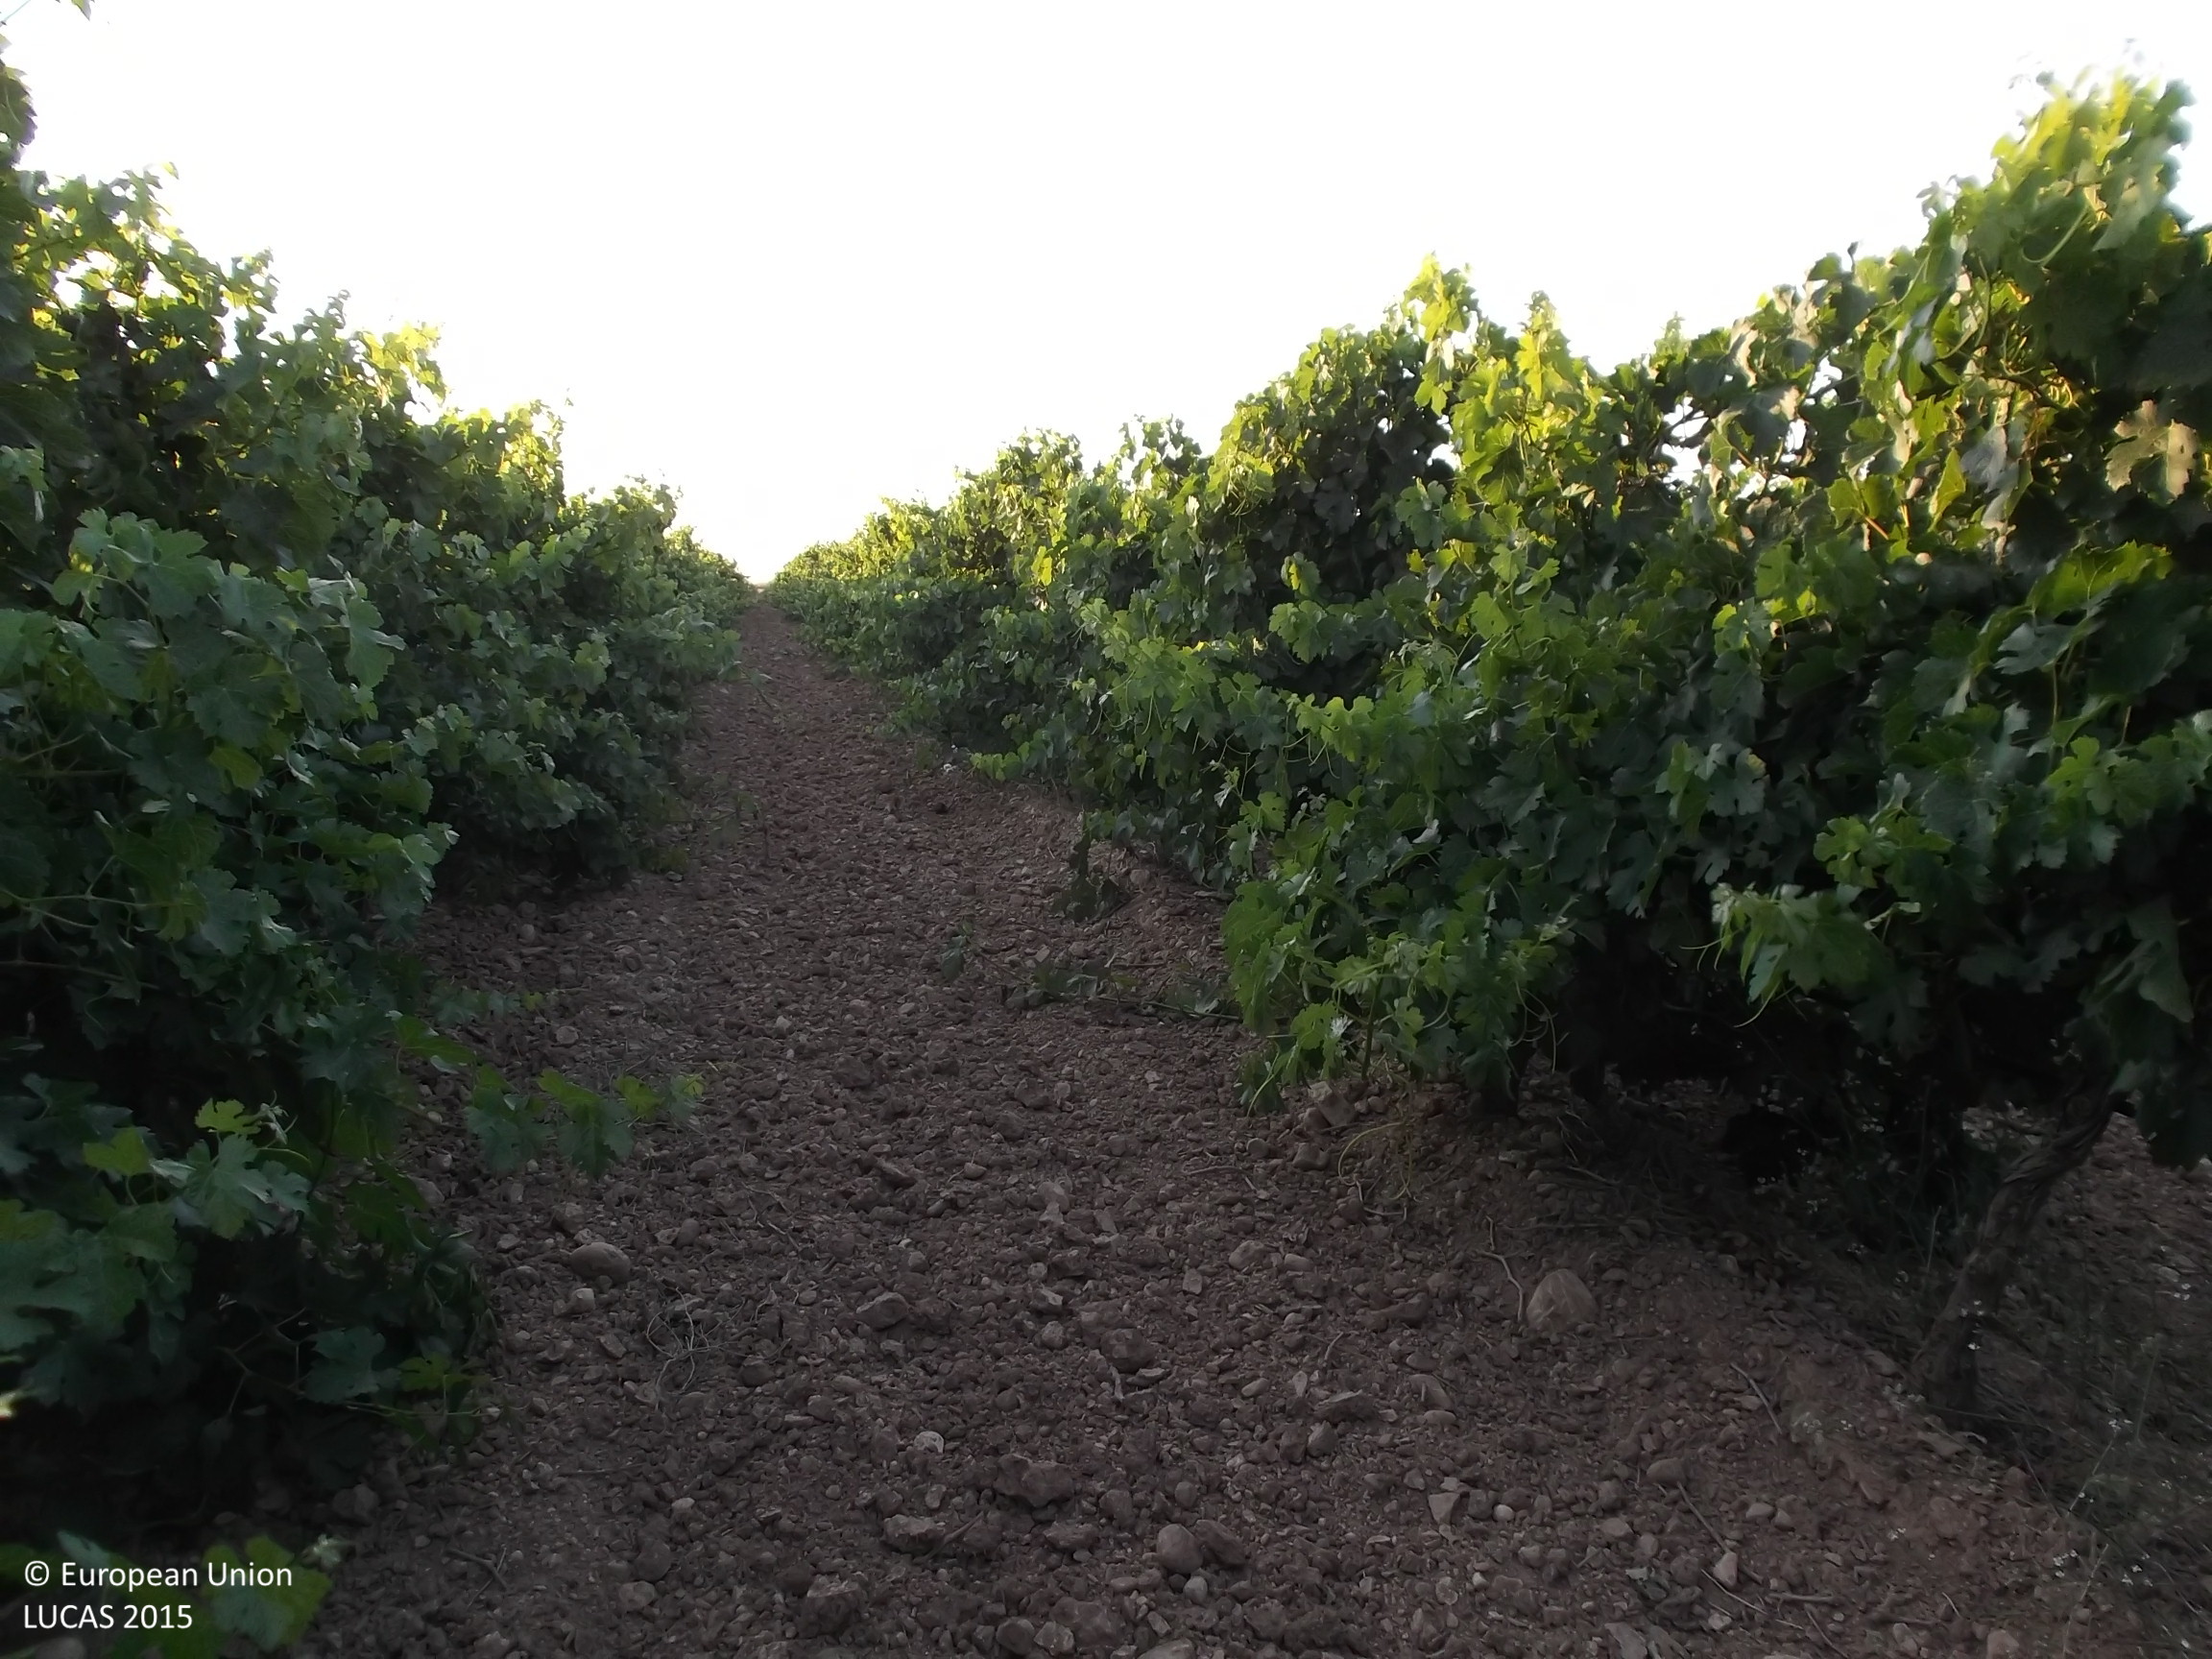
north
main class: Cropland
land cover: Vineyards
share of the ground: 10 - 25 %
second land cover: Other bare soil
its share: > 75 %
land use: Agriculture (excluding fallow land and kitchen gardens)
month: July
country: ES
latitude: 42.4356
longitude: -1.6447
